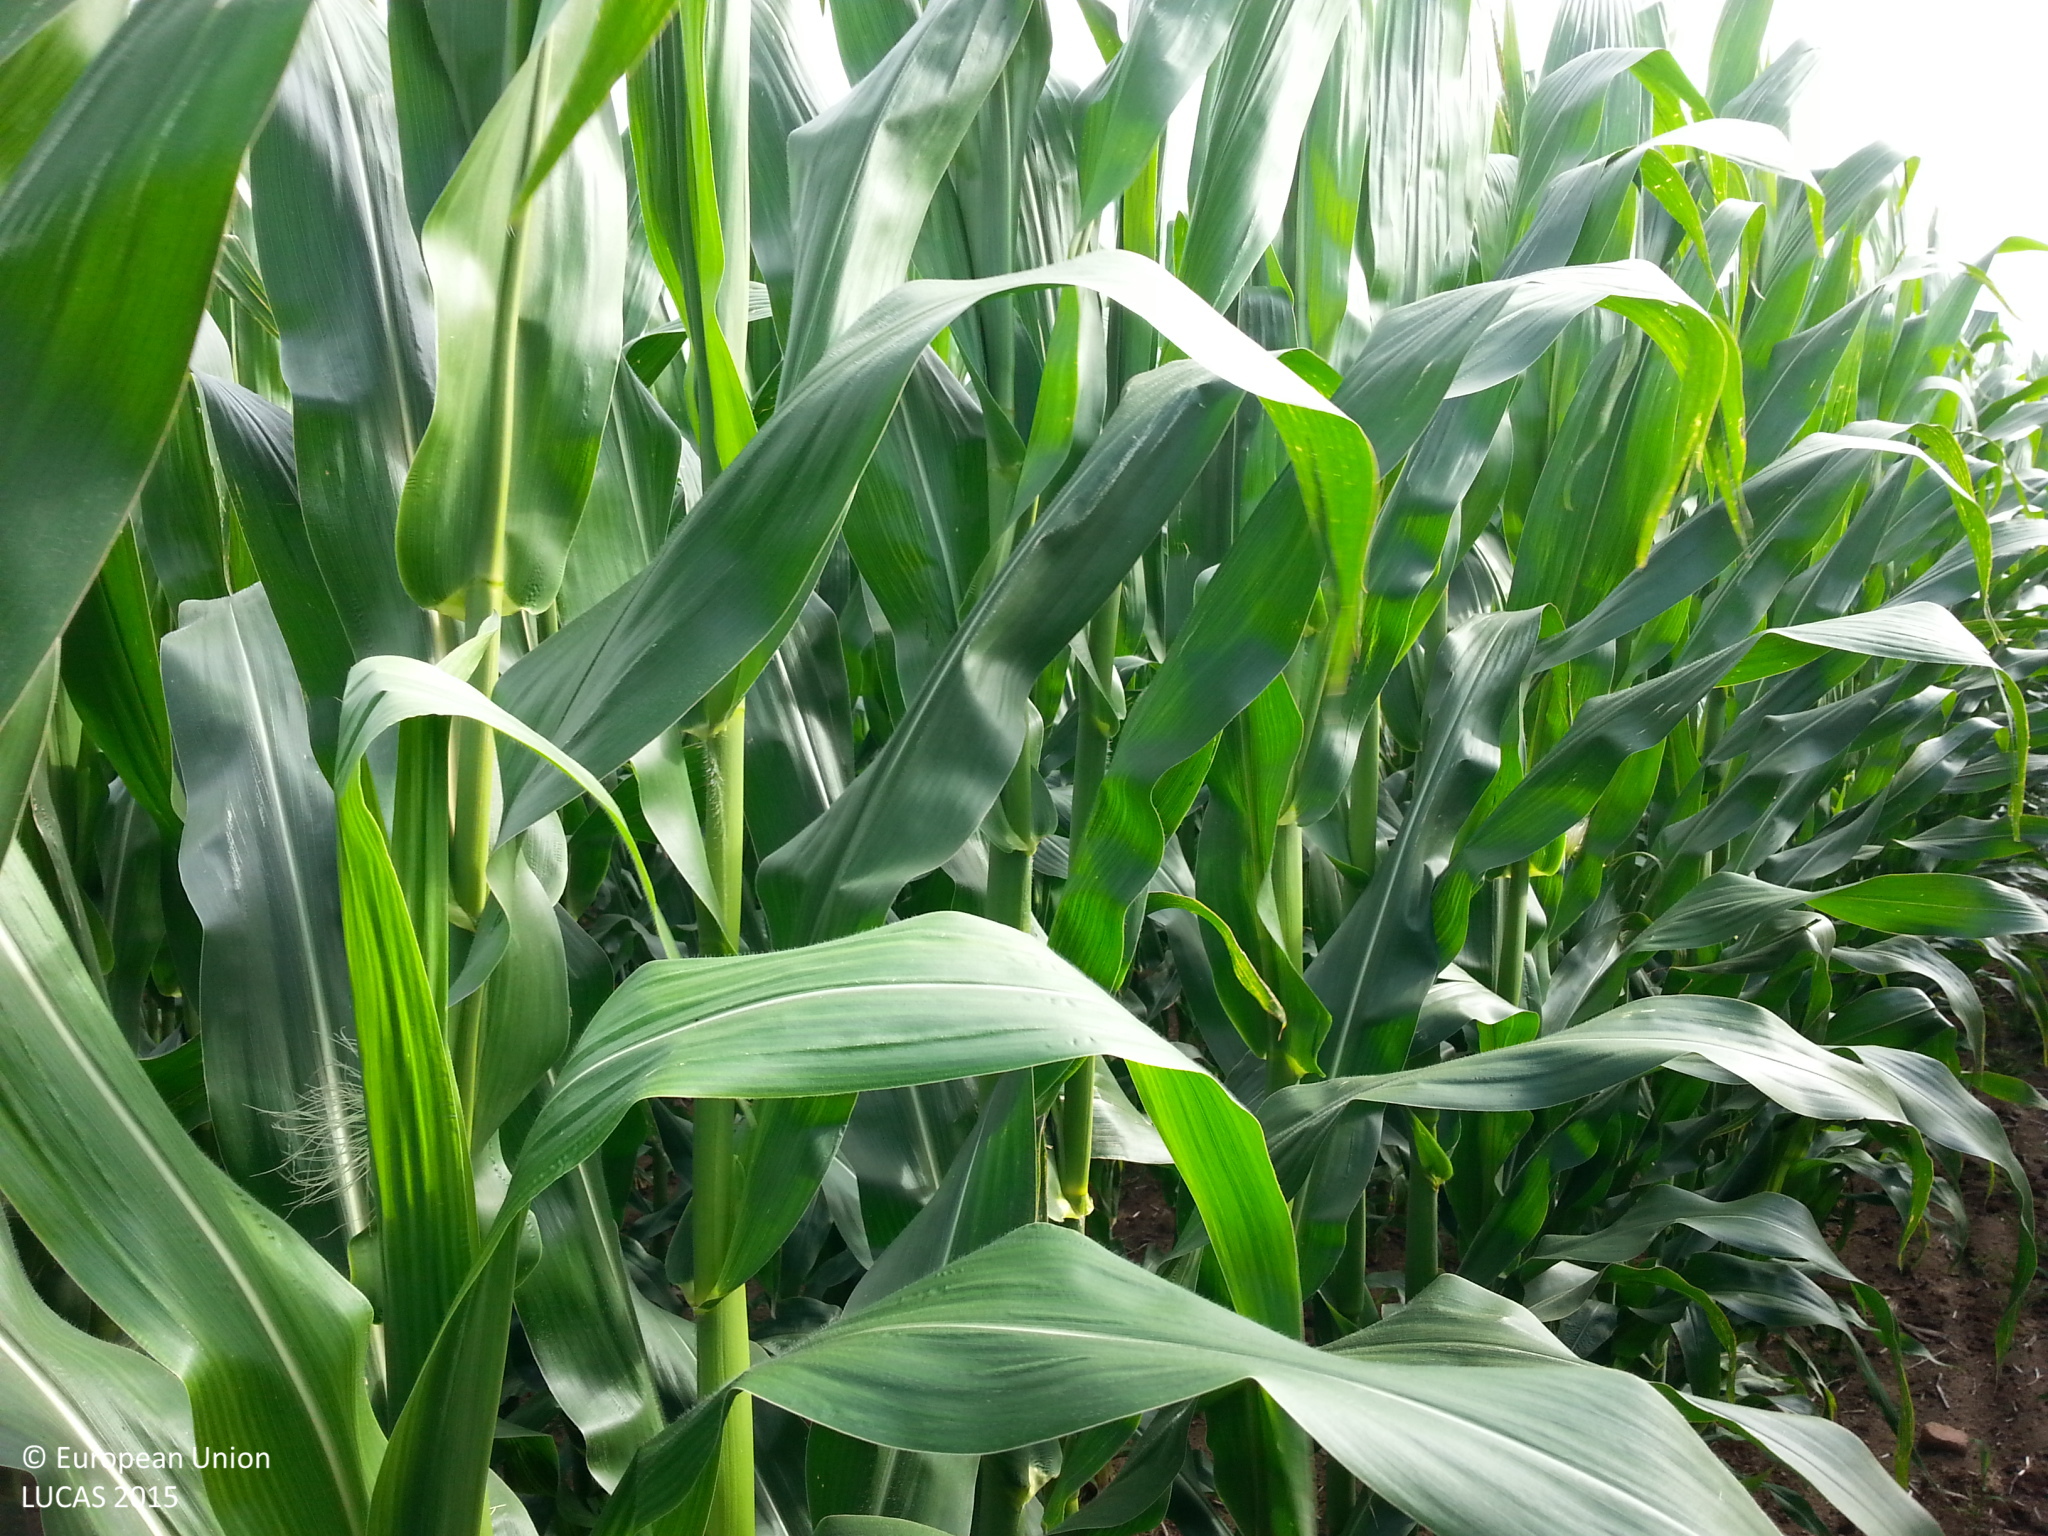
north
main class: Cropland
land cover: Maize
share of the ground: > 75 %
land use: Agriculture (excluding fallow land and kitchen gardens)
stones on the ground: < 10 %
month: July
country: DE
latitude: 53.2155
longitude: 12.4404
